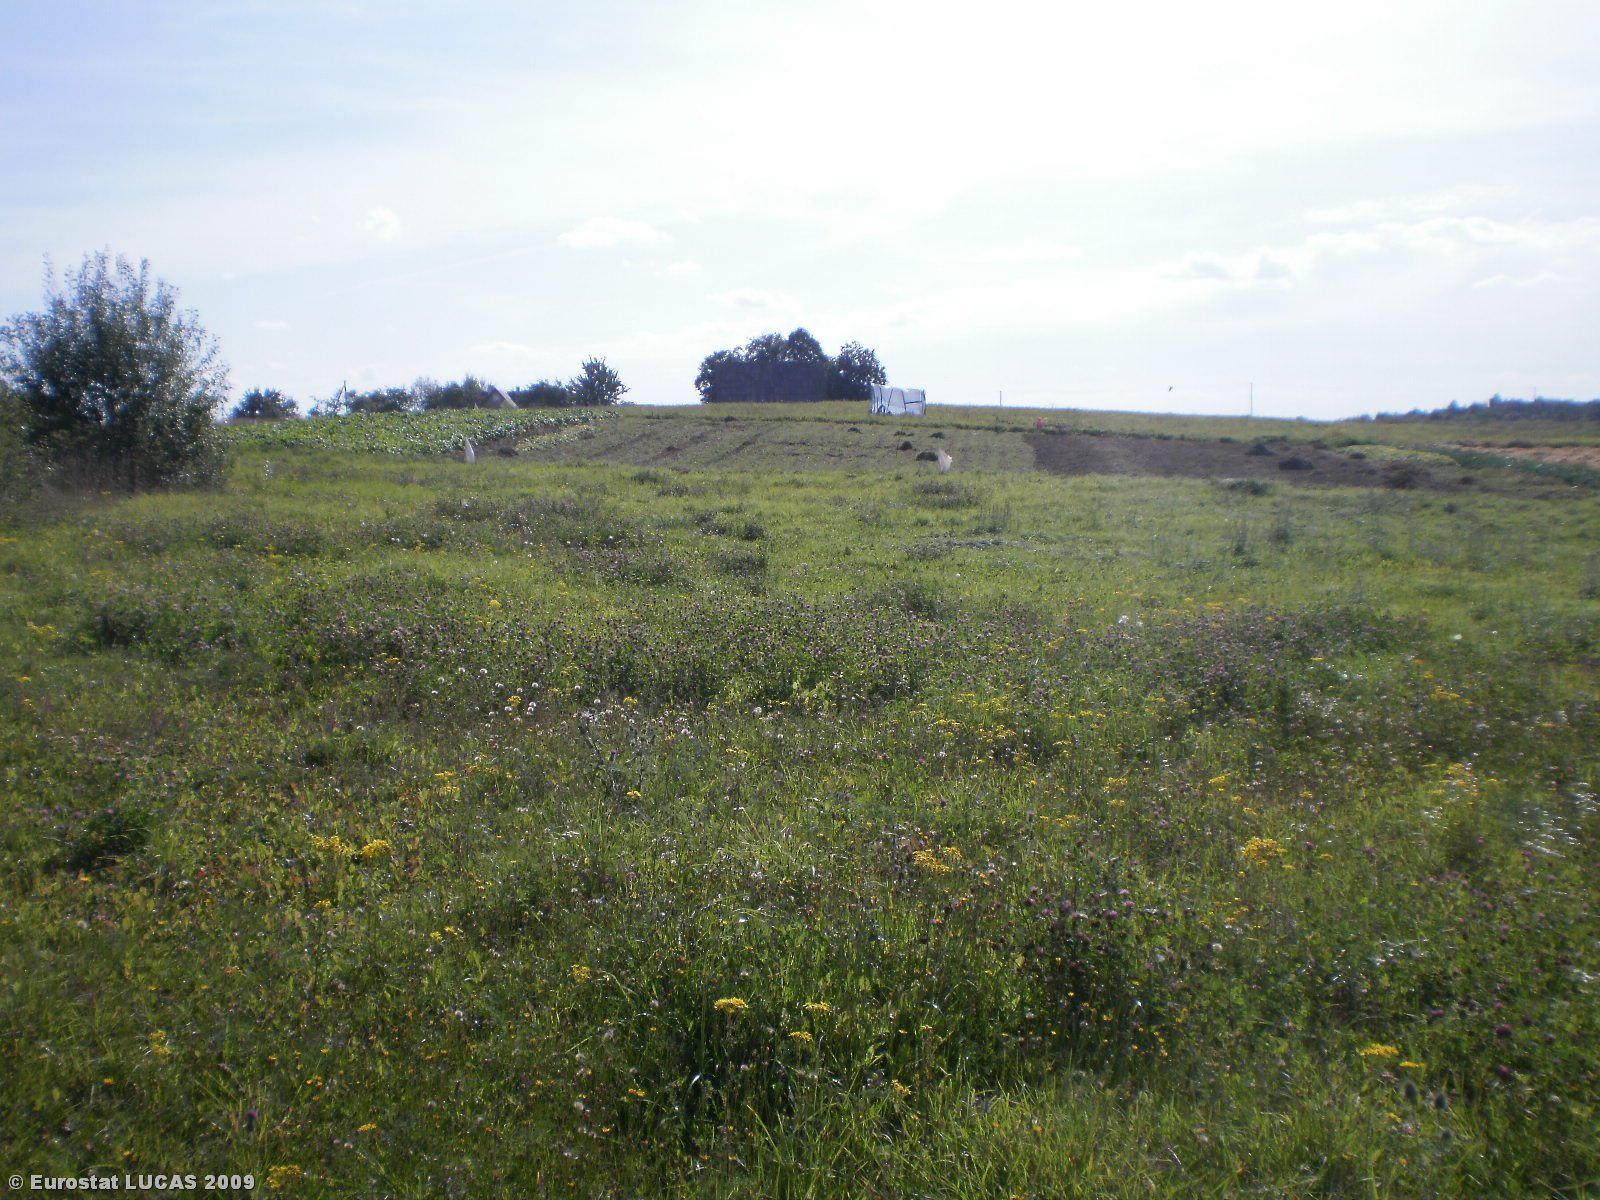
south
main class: Grassland
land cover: Grassland without tree/shrub cover
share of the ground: > 75 %
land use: Agriculture (excluding fallow land and kitchen gardens)
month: August
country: LT
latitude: 54.9288
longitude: 24.5697
